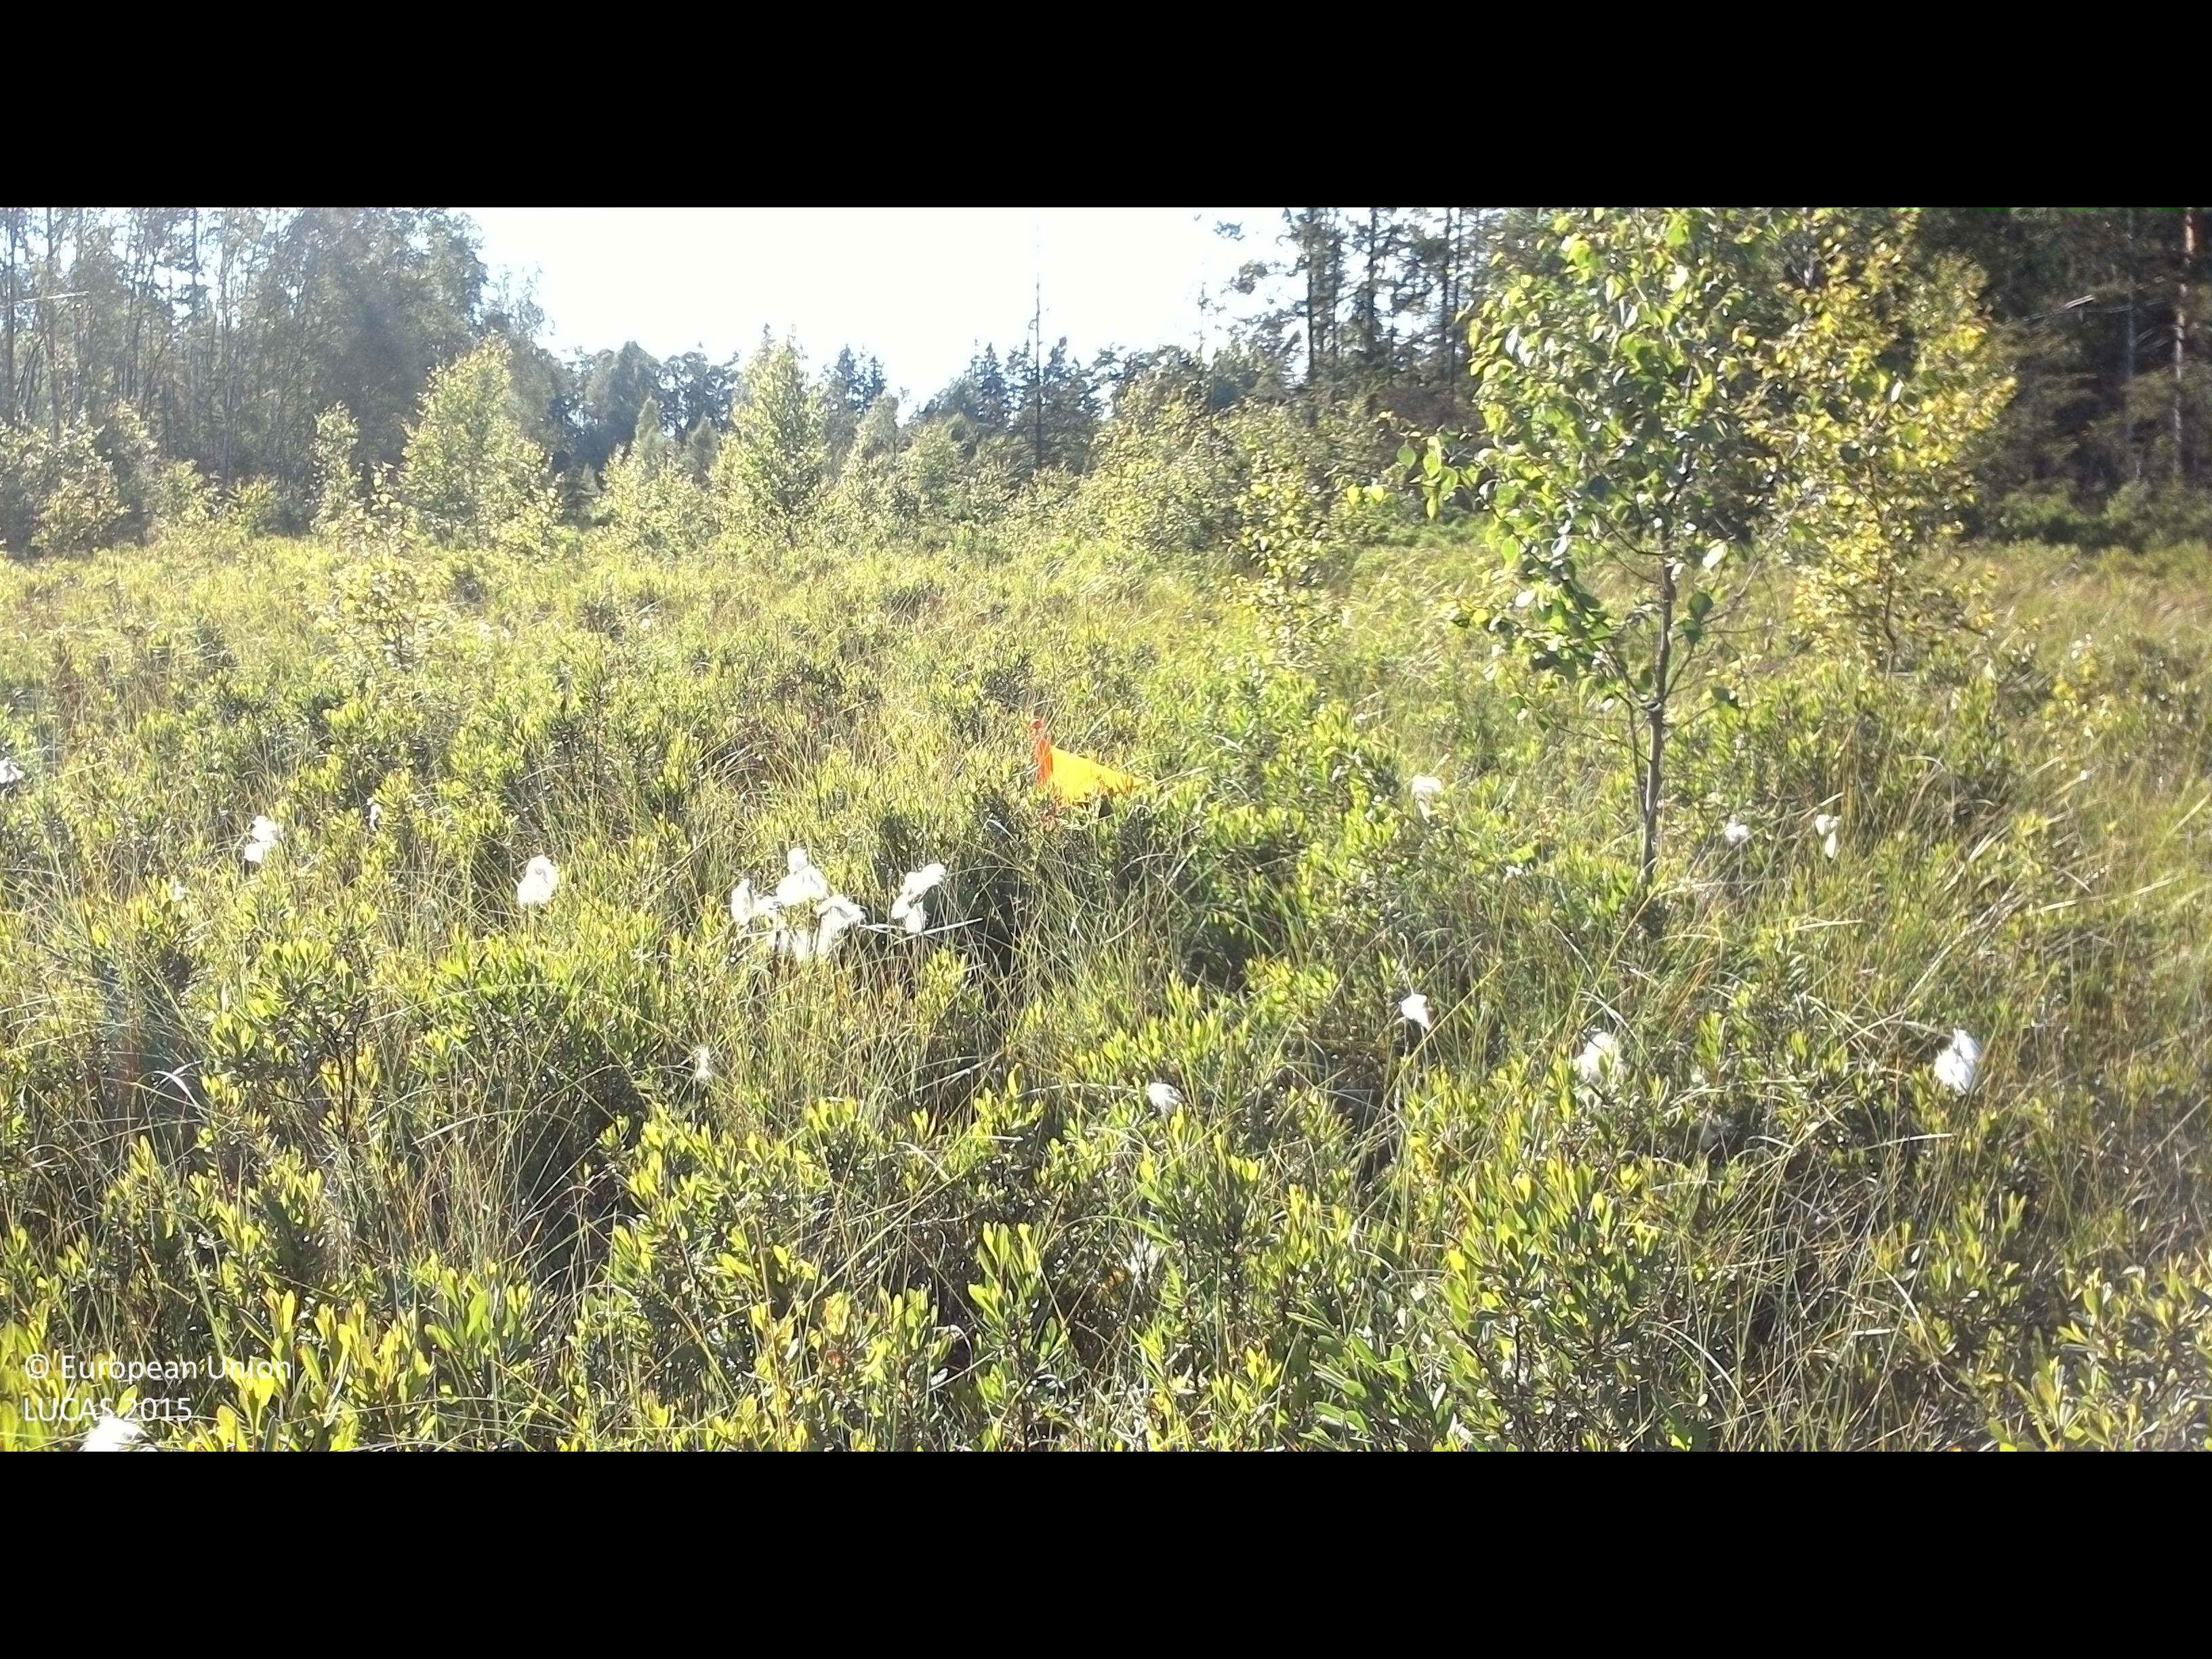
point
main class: Shrubland
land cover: Shrubland with sparse tree cover
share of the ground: > 75 %
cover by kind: shrubs 85 %, broadleaved forest trees 5 %, herbaceous plants 5 %, lichens and mosses 5 %
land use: Semi-natural and natural areas not in use
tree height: < 5 m
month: July
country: SE
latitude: 56.4631
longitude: 15.1432
